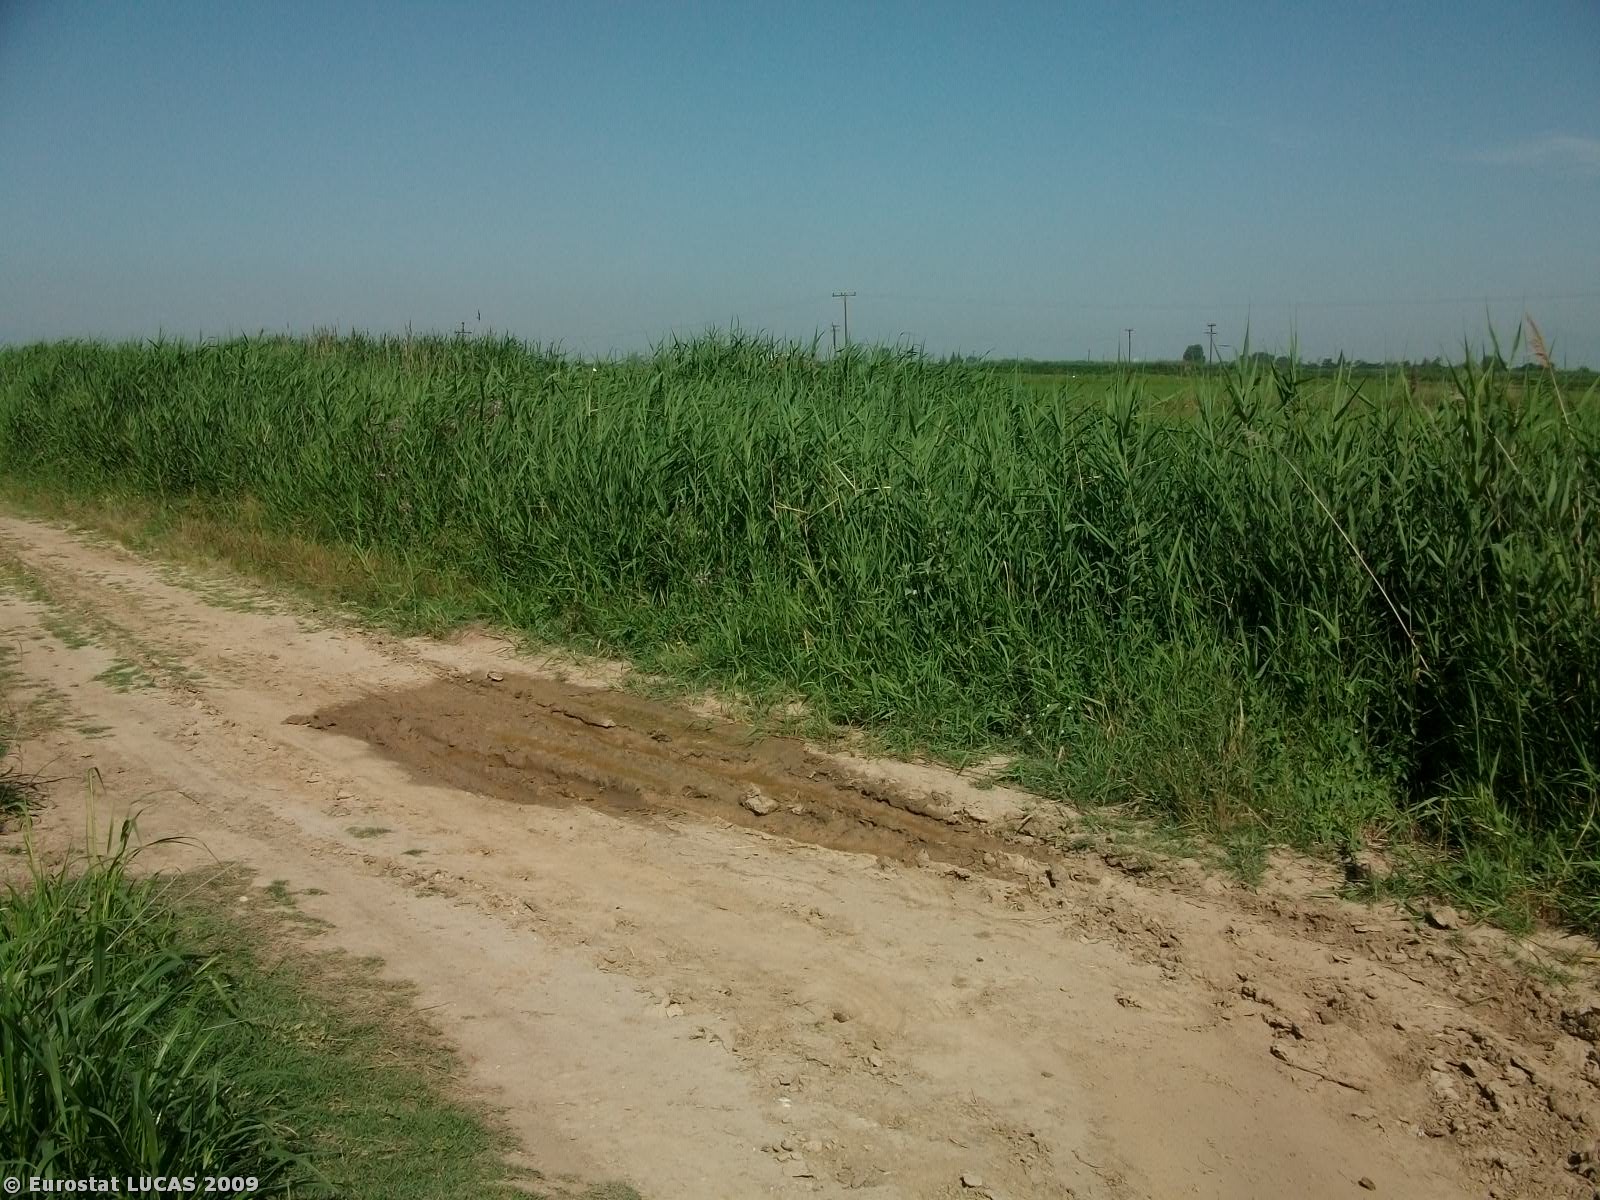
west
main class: Cropland
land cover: Rice
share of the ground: > 75 %
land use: Agriculture (excluding fallow land and kitchen gardens)
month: June
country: GR
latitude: 40.5927
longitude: 22.6823
